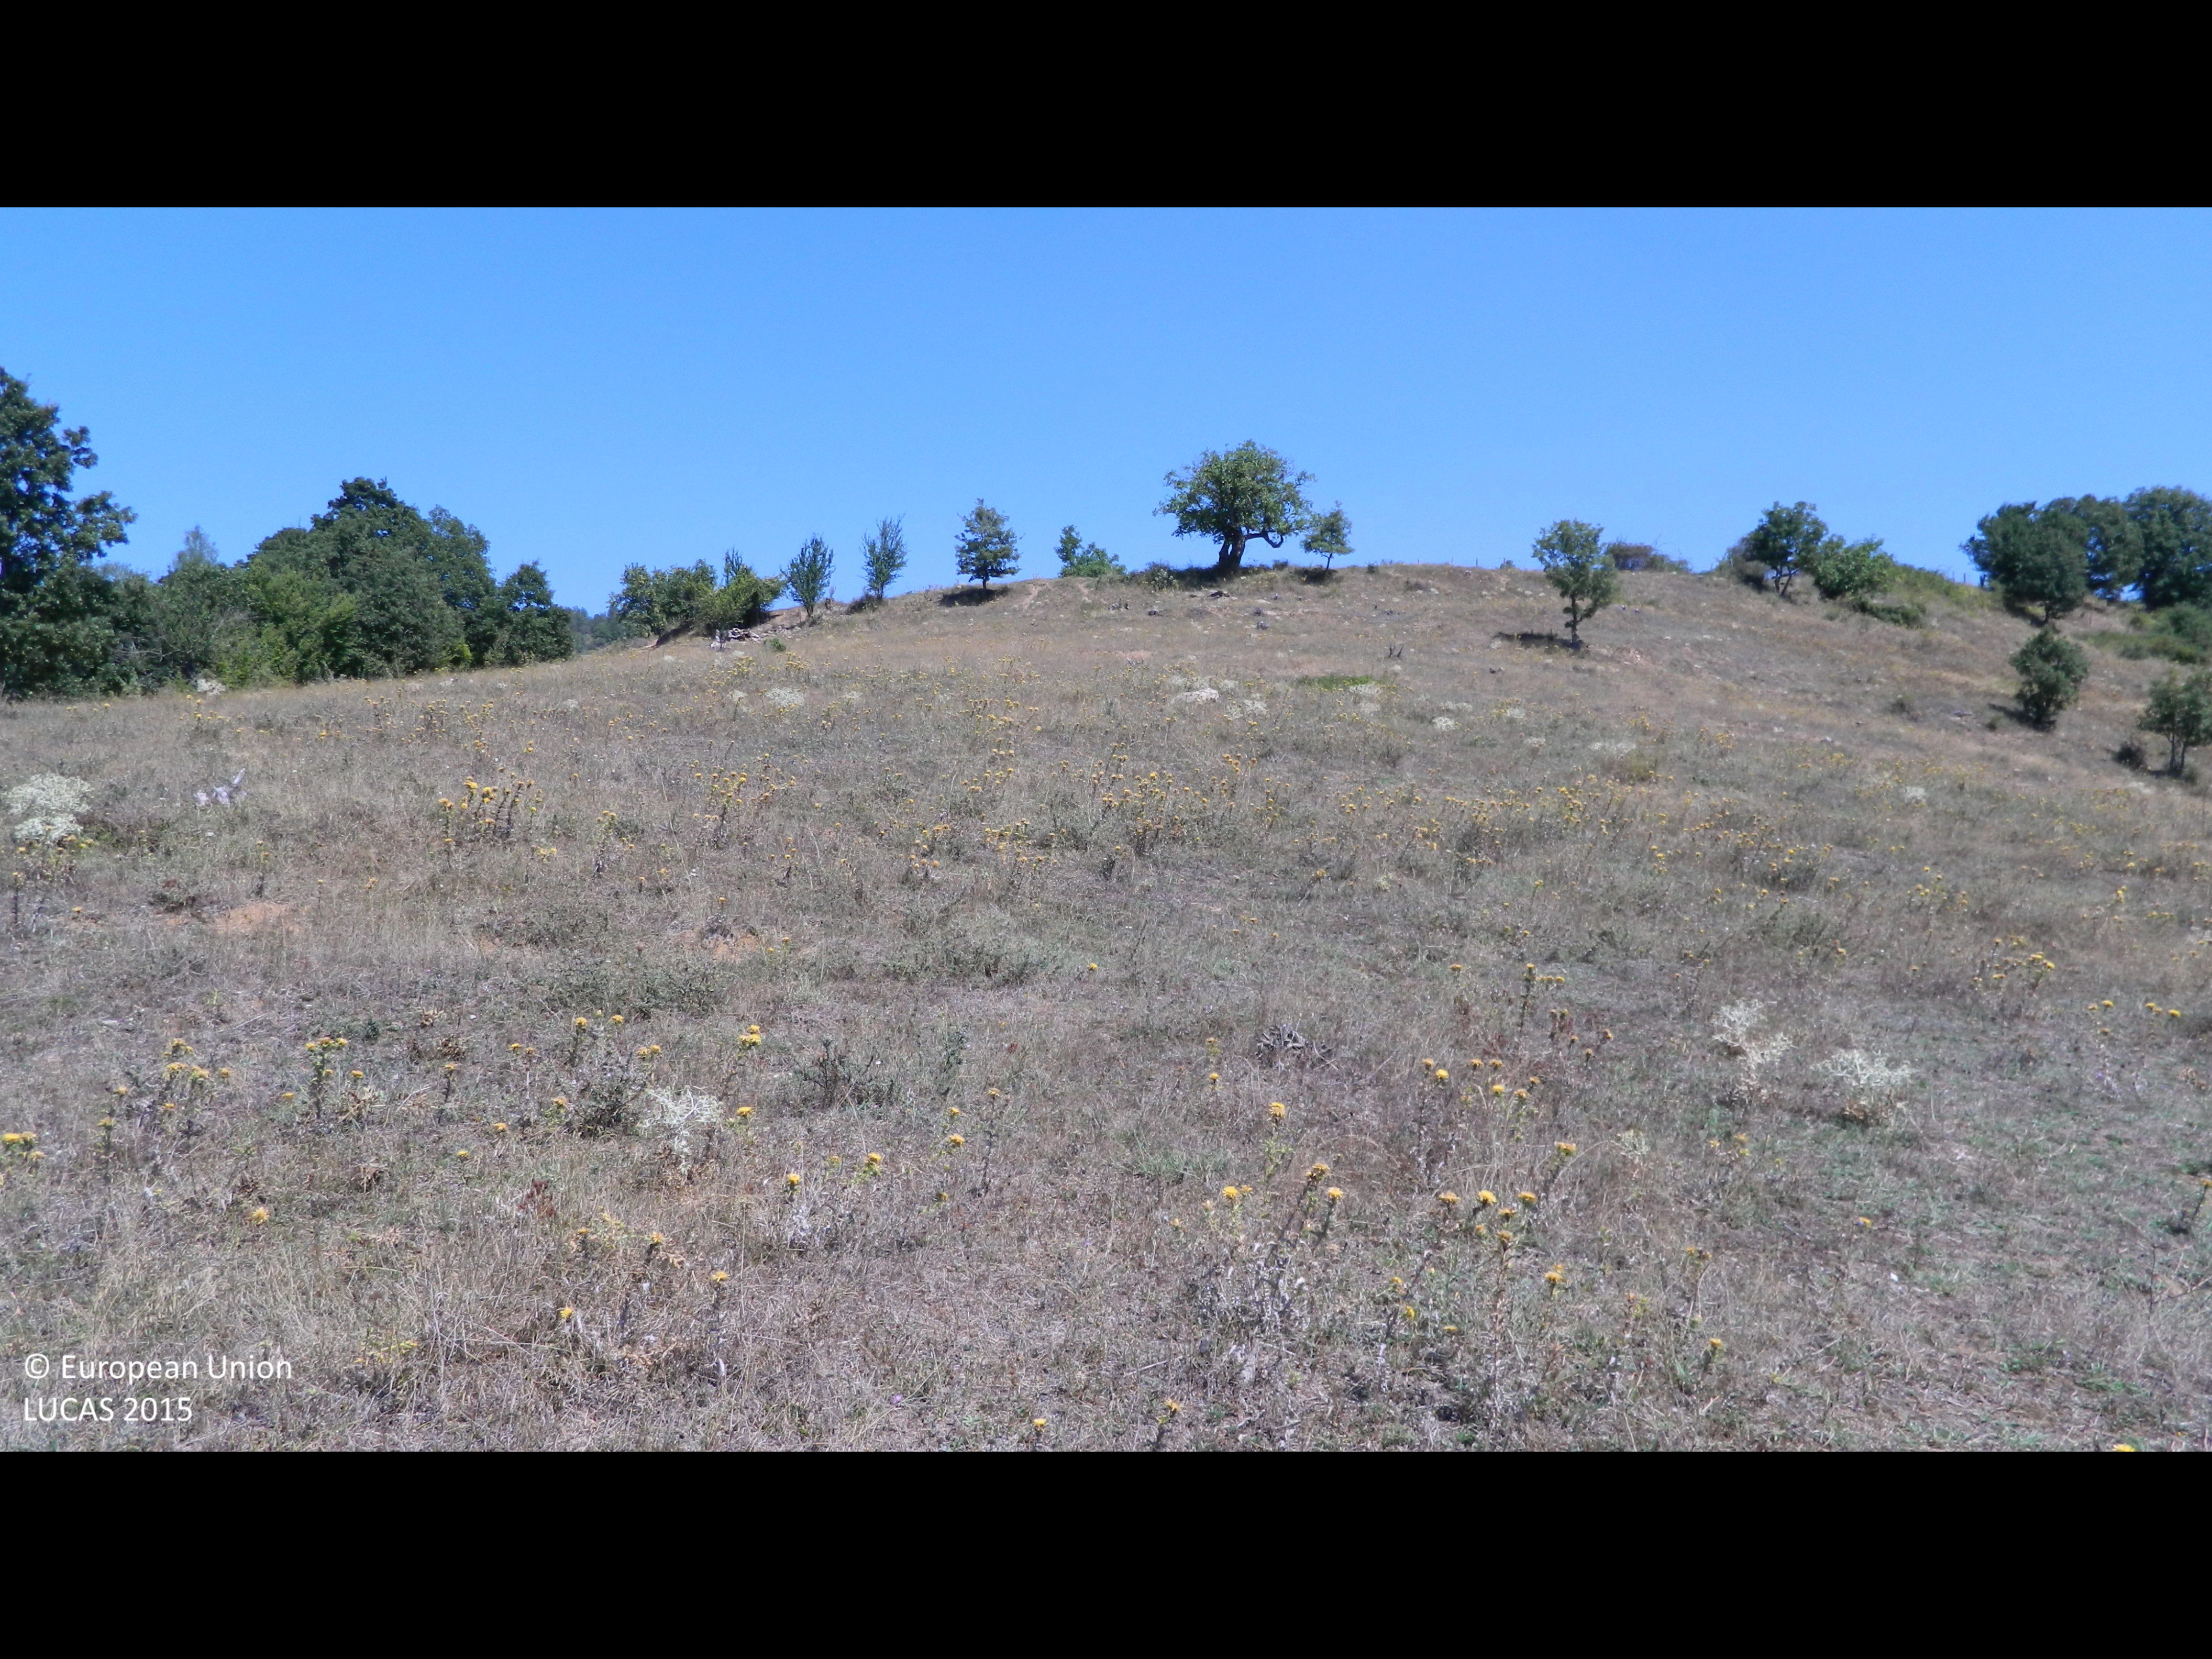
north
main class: Grassland
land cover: Grassland without tree/shrub cover
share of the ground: > 75 %
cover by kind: herbaceous plants 95 %, shrubs 5 %
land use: Agriculture (excluding fallow land and kitchen gardens)
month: August
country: BG
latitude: 41.5357
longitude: 25.8997
